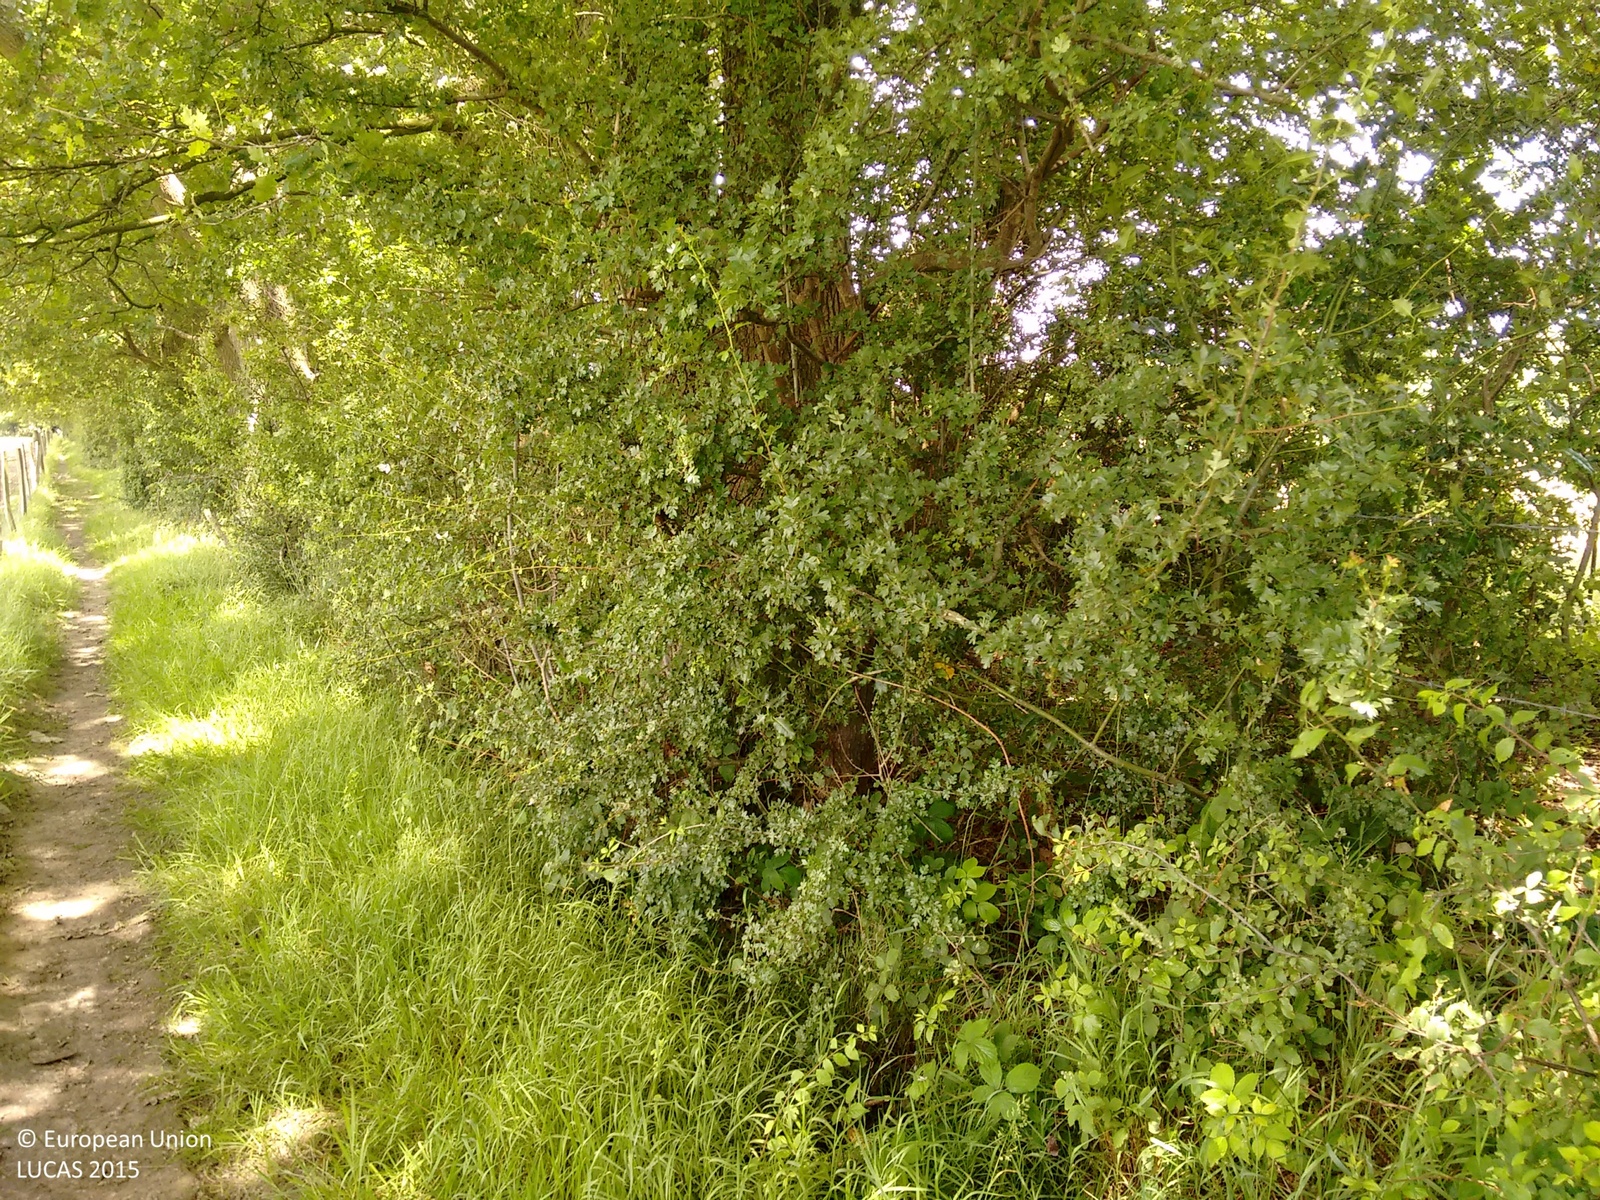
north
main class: Grassland
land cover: Grassland without tree/shrub cover
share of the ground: > 75 %
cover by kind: herbaceous plants 100 %
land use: Agriculture (excluding fallow land and kitchen gardens)
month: June
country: GB
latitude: 51.1625
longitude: -0.1444
